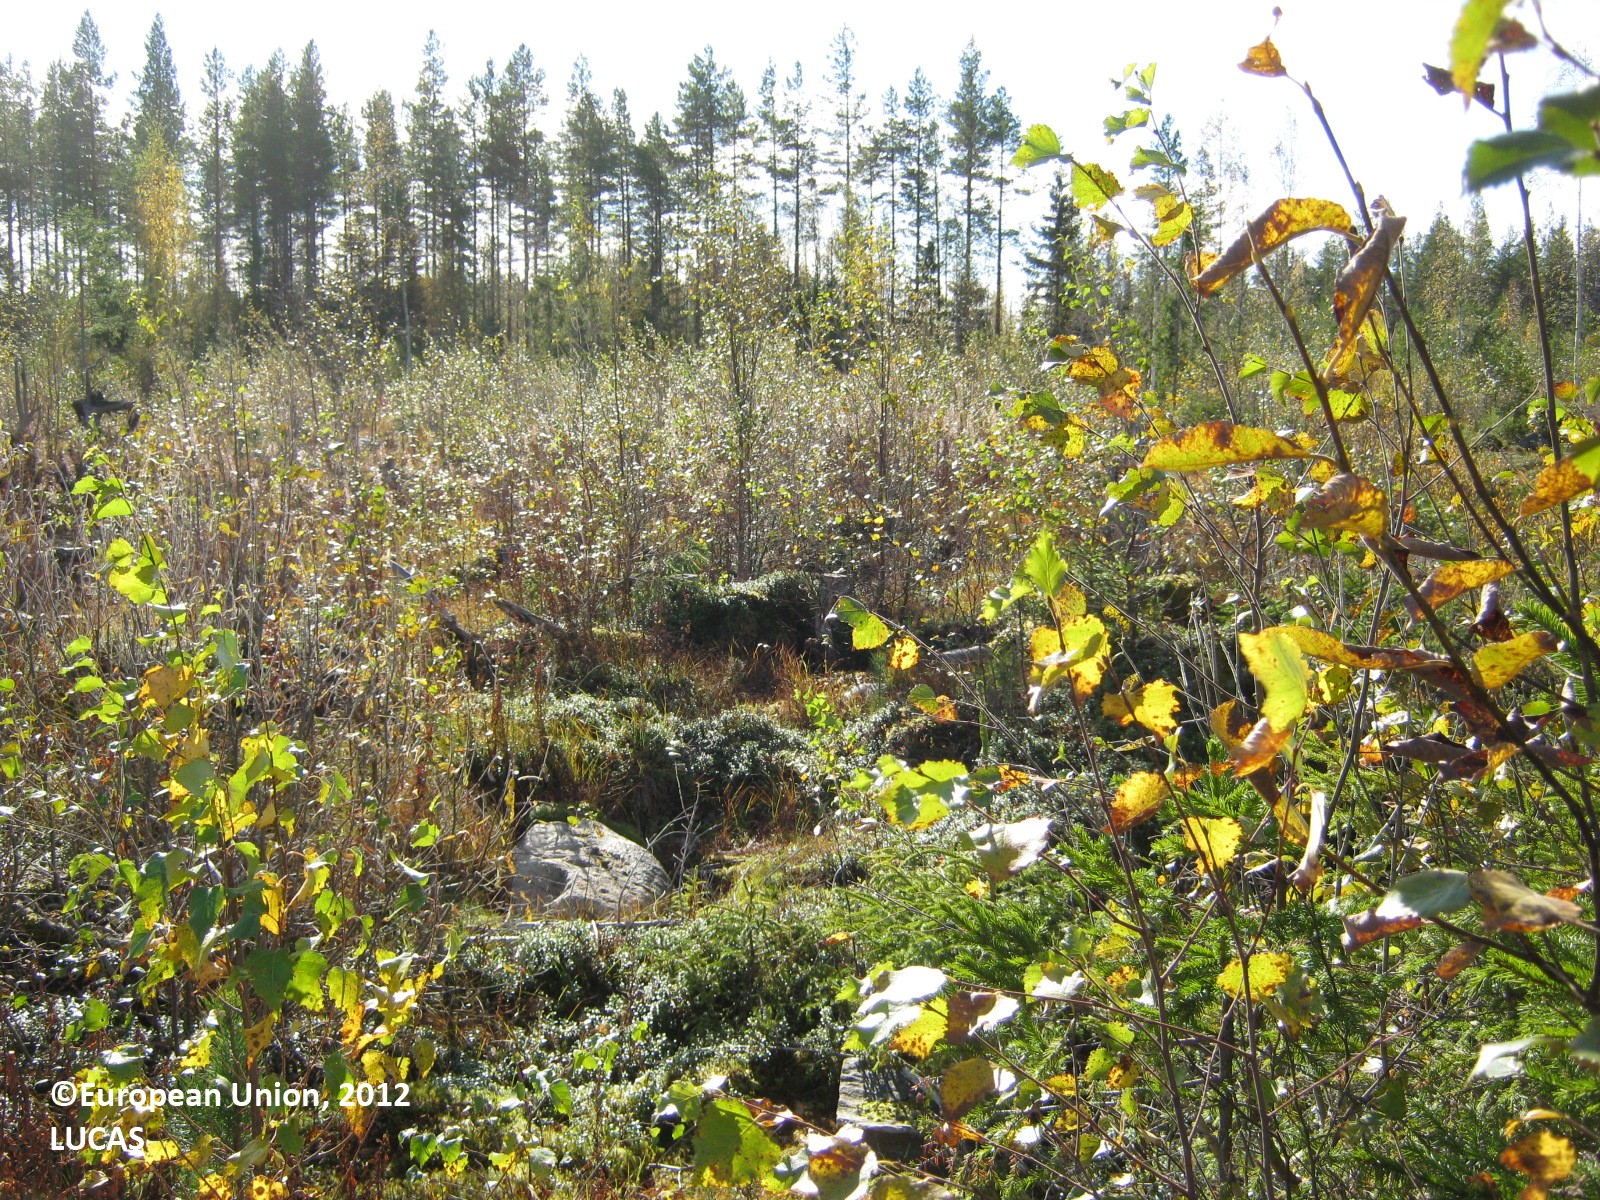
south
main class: Woodland
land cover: Broadleaved woodland
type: boreal forest
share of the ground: > 75 %
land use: Forestry
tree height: < 5 m
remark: Clear cut
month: September
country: FI
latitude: 63.4285
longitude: 25.8400
